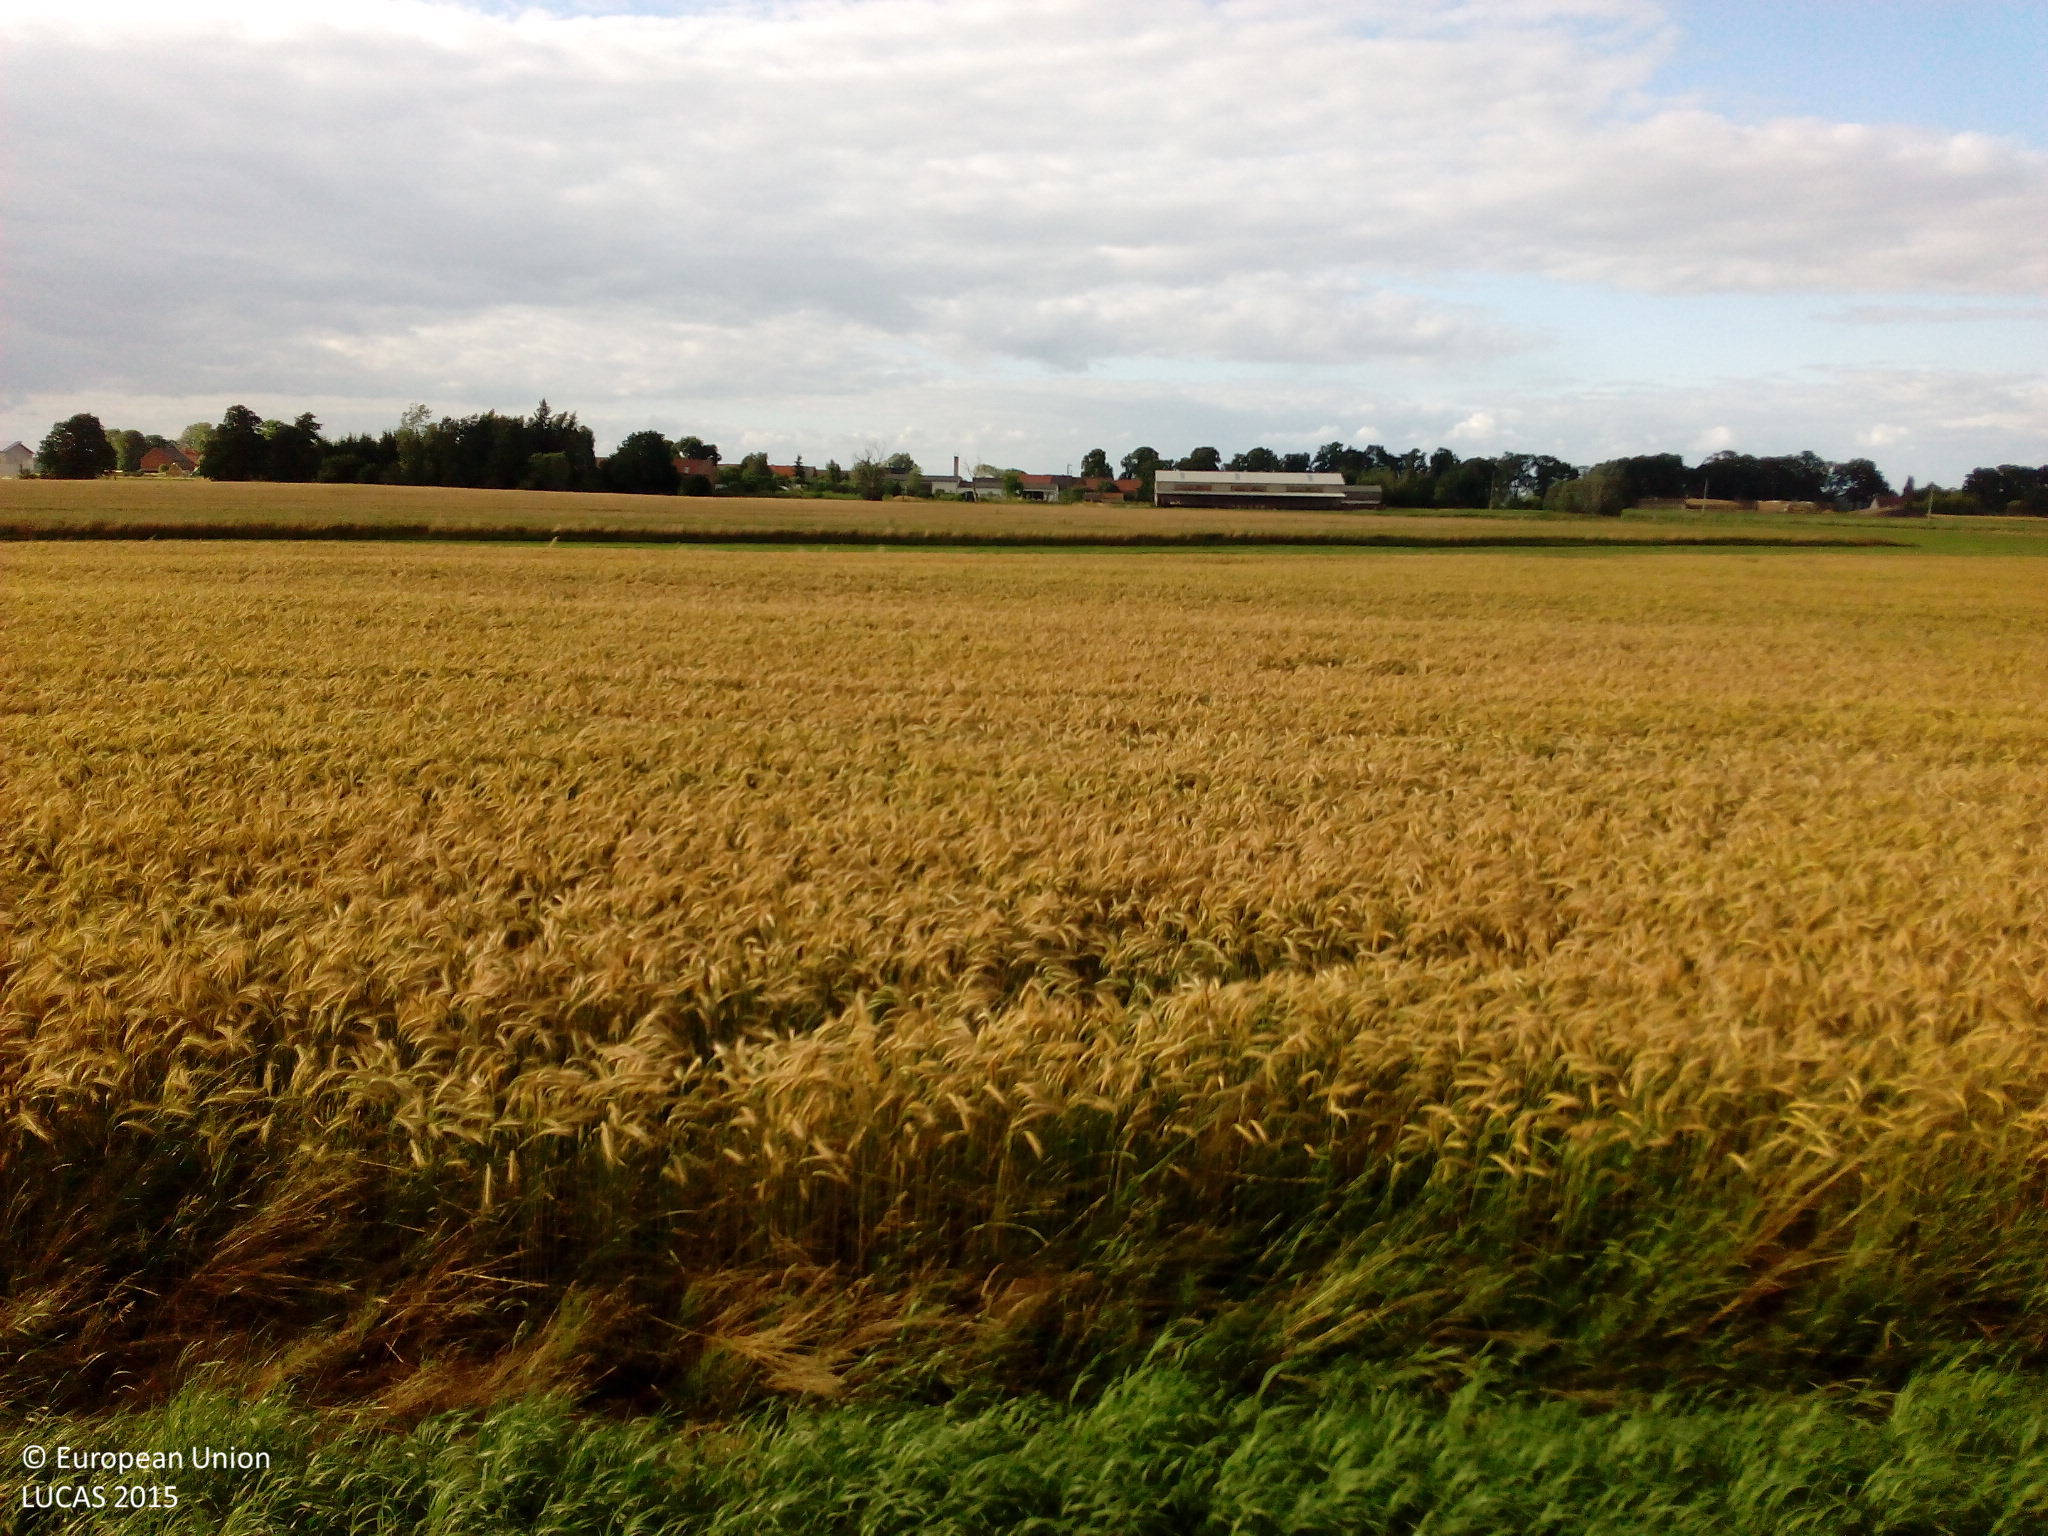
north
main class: Grassland
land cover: Grassland without tree/shrub cover
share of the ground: > 75 %
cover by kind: herbaceous plants 100 %
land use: Protection infrastructures
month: July
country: DE
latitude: 52.7862
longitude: 12.3274
